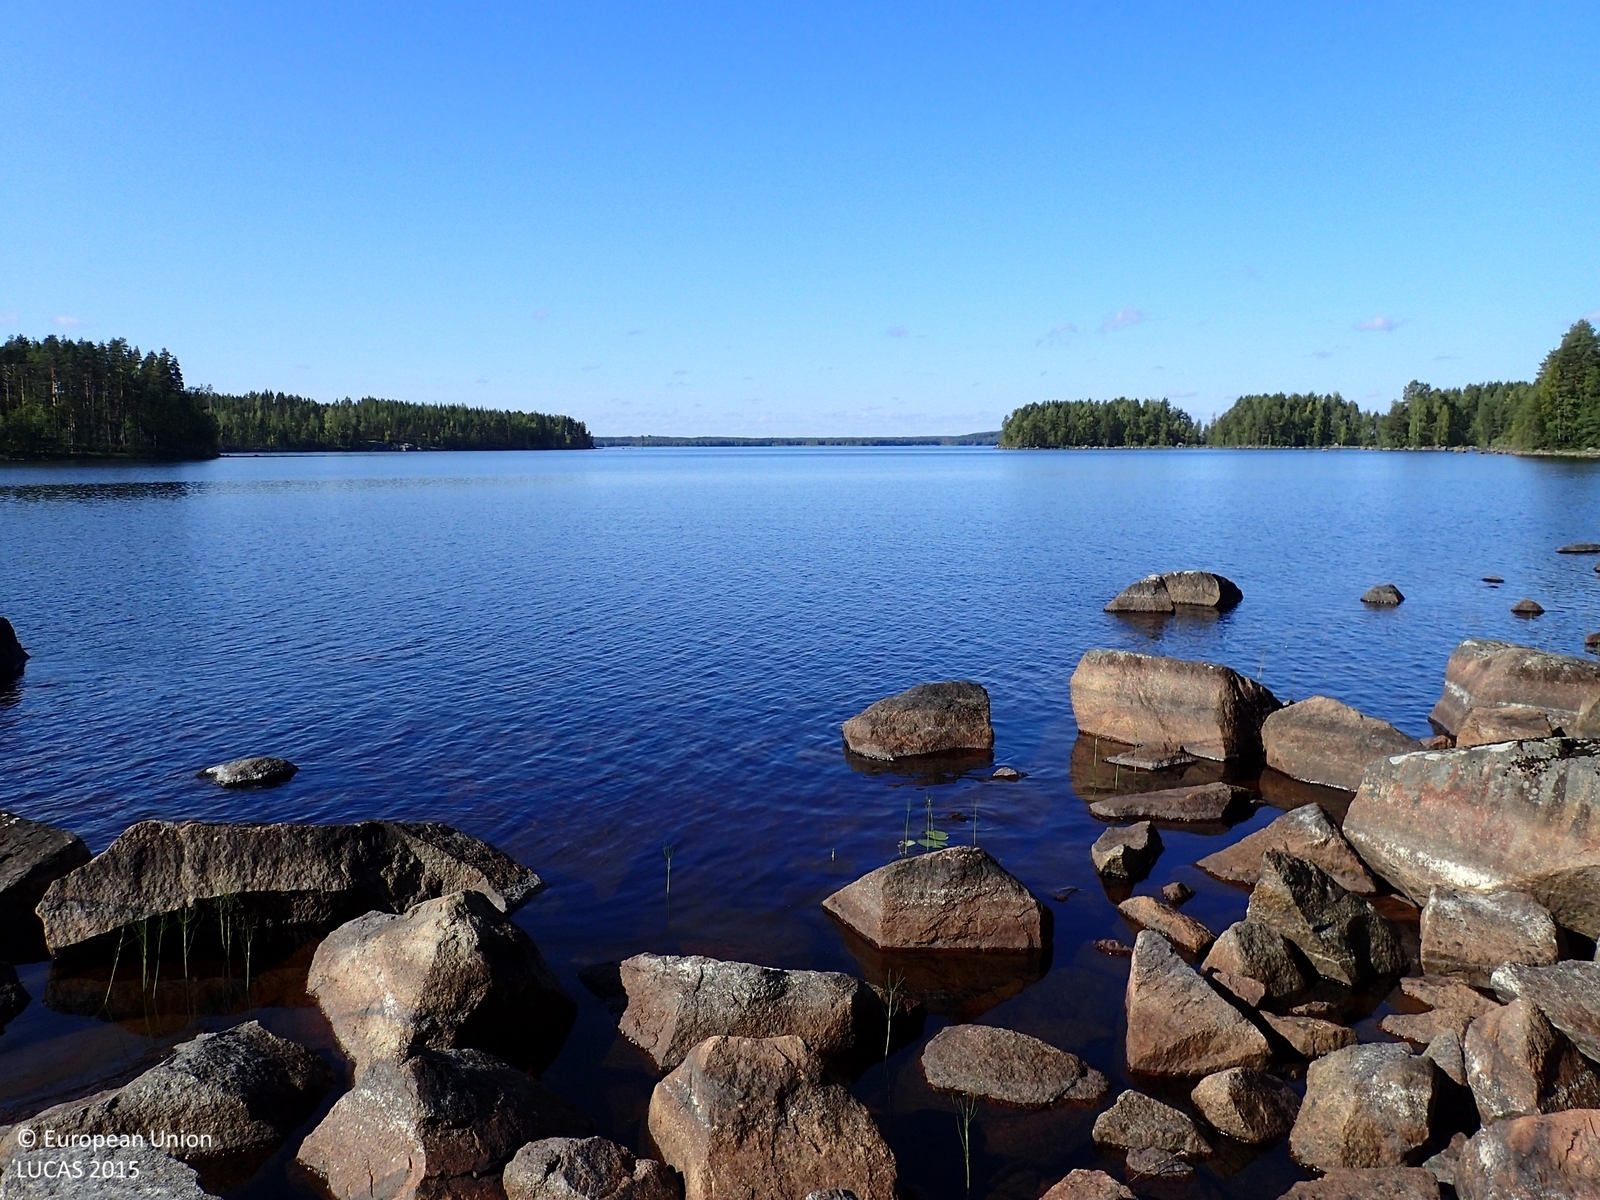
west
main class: Woodland
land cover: Broadleaved woodland
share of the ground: > 75 %
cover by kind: broadleaved forest trees 80 %, coniferous forest trees 10 %, shrubs 10 %
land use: Semi-natural and natural areas not in use
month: September
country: FI
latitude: 63.1394
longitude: 25.2358
